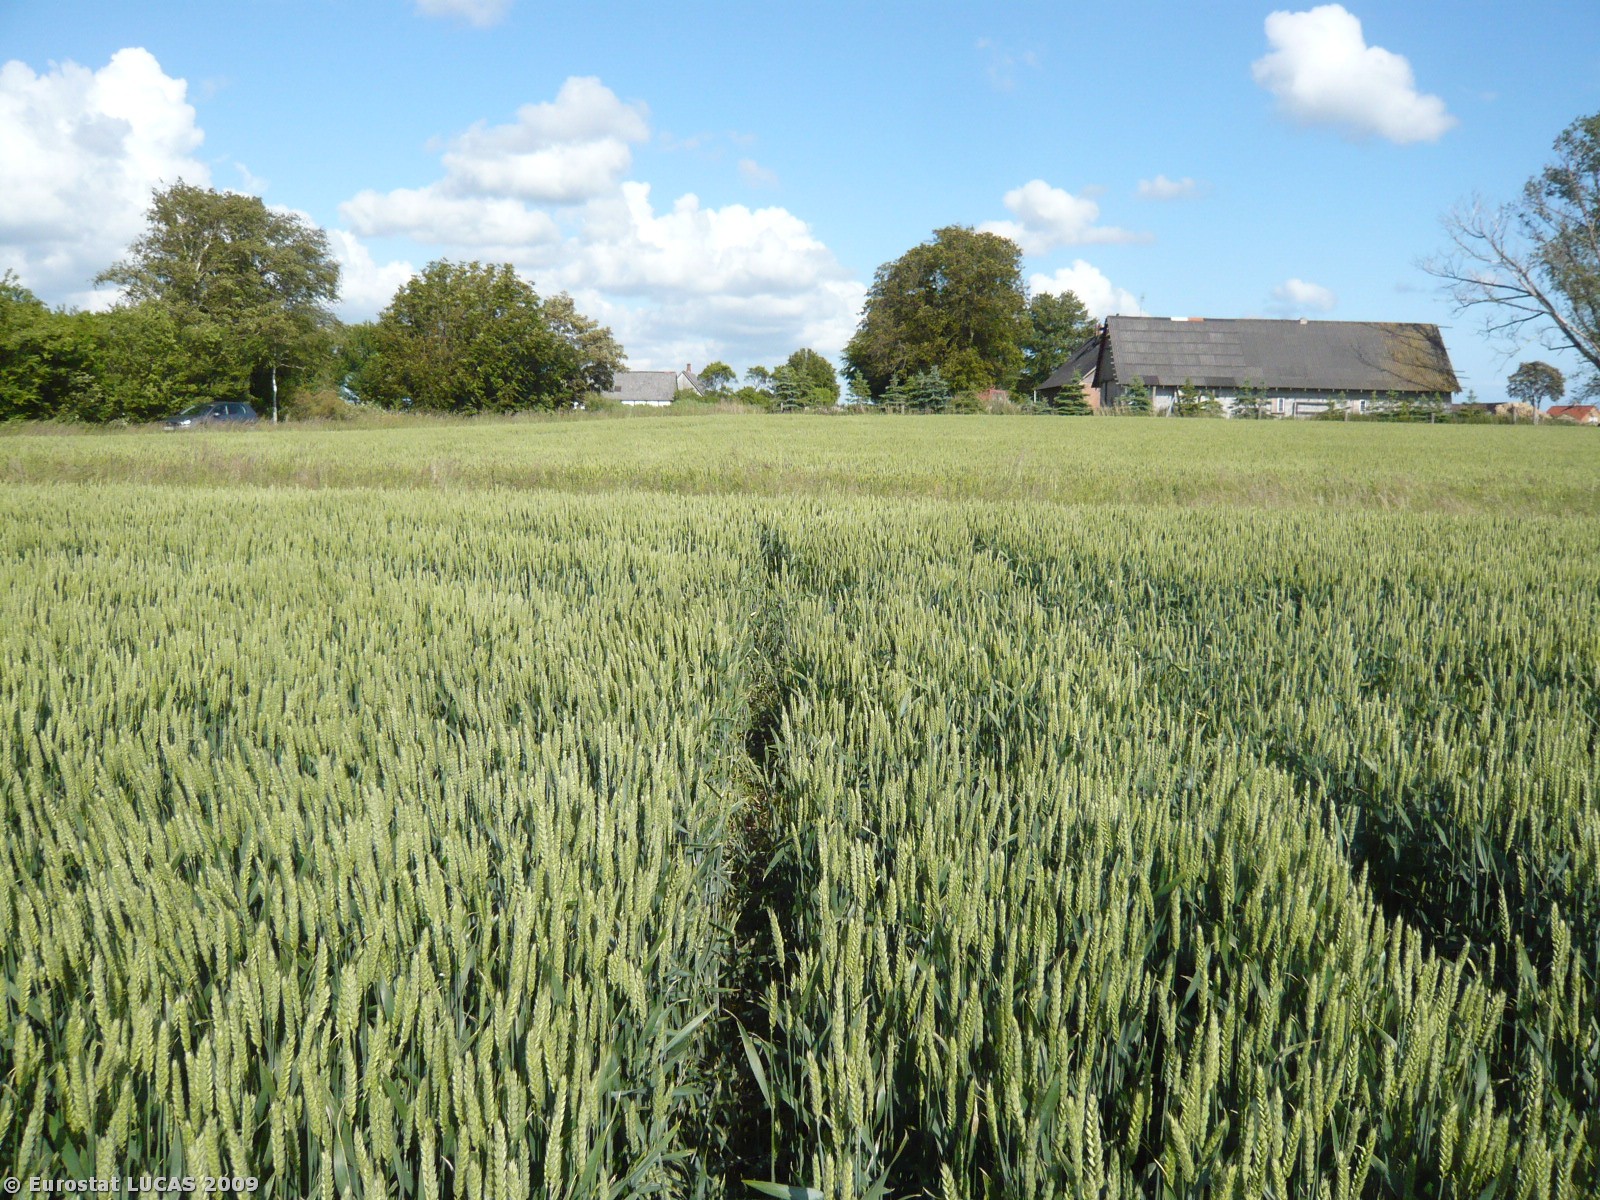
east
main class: Cropland
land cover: Common wheat
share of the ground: > 75 %
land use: Agriculture (excluding fallow land and kitchen gardens)
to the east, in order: Common wheat; Grassland without tree/shrub cover; Ditches and canals; Grass margins; Common wheat; Grassland without tree/shrub cover; Paved roads, cycling and walking lanes; Grass margins; Ditches and canals; Fences; Broadleaved woodland; Barley; Fences; Grassland without tree/shrub cover; Artificial constructions in urban areas; Fences; Barley
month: June
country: DK
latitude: 54.7044
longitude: 11.5354
